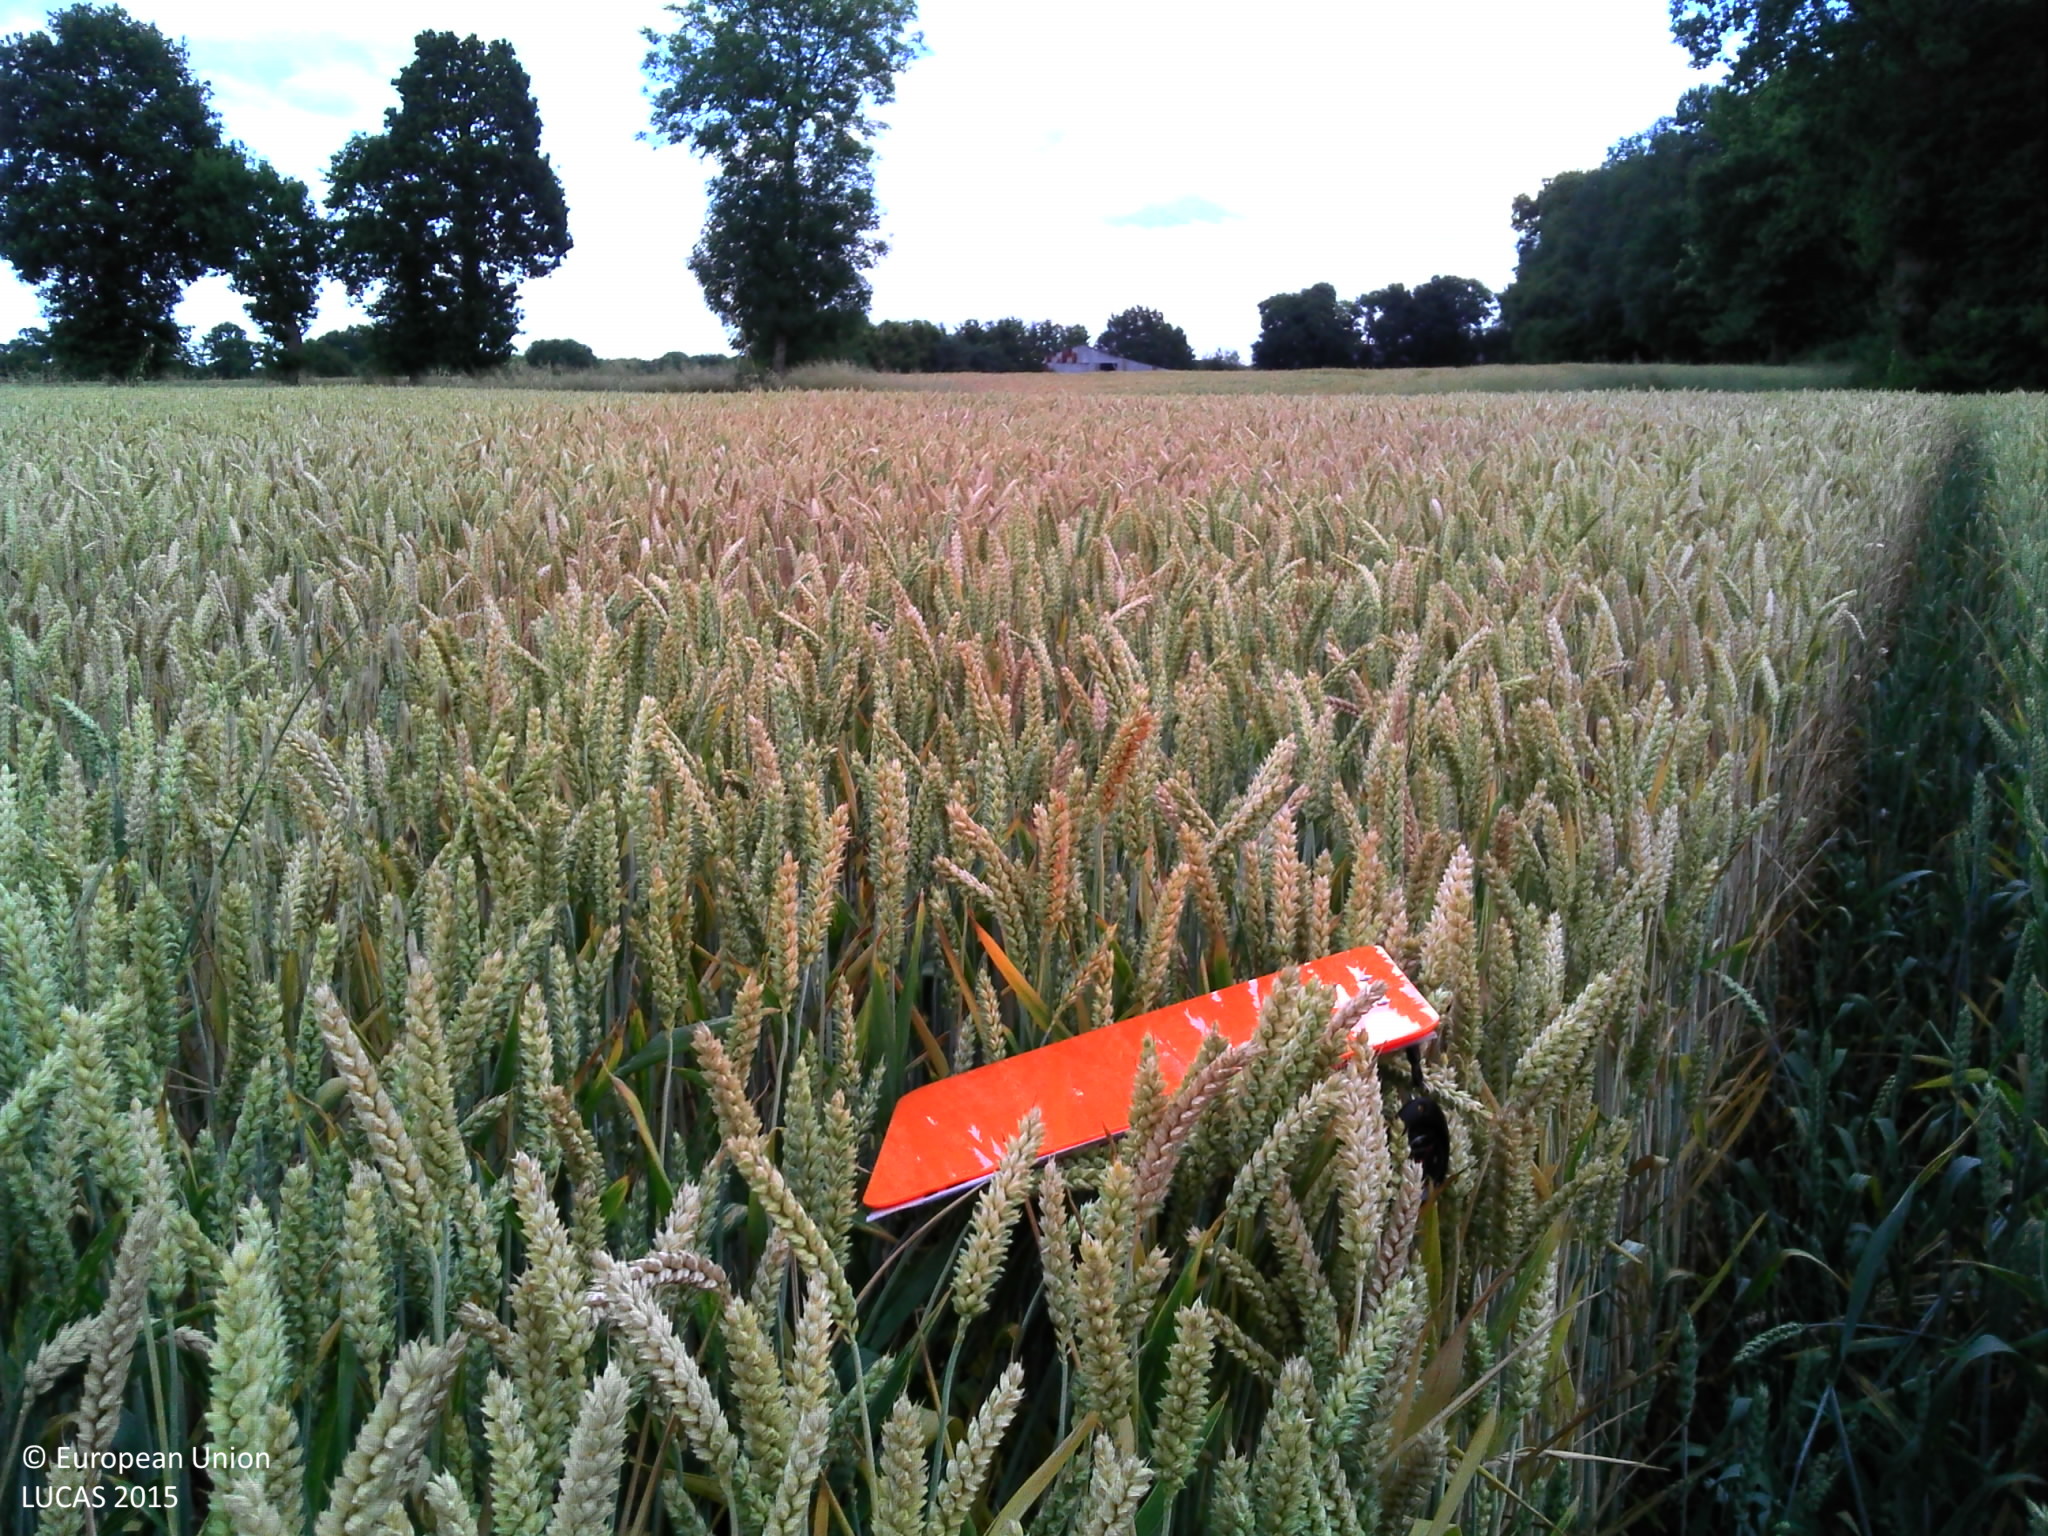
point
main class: Cropland
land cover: Common wheat
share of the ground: > 75 %
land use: Agriculture (excluding fallow land and kitchen gardens)
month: July
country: FR
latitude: 48.2802
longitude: -2.1156
